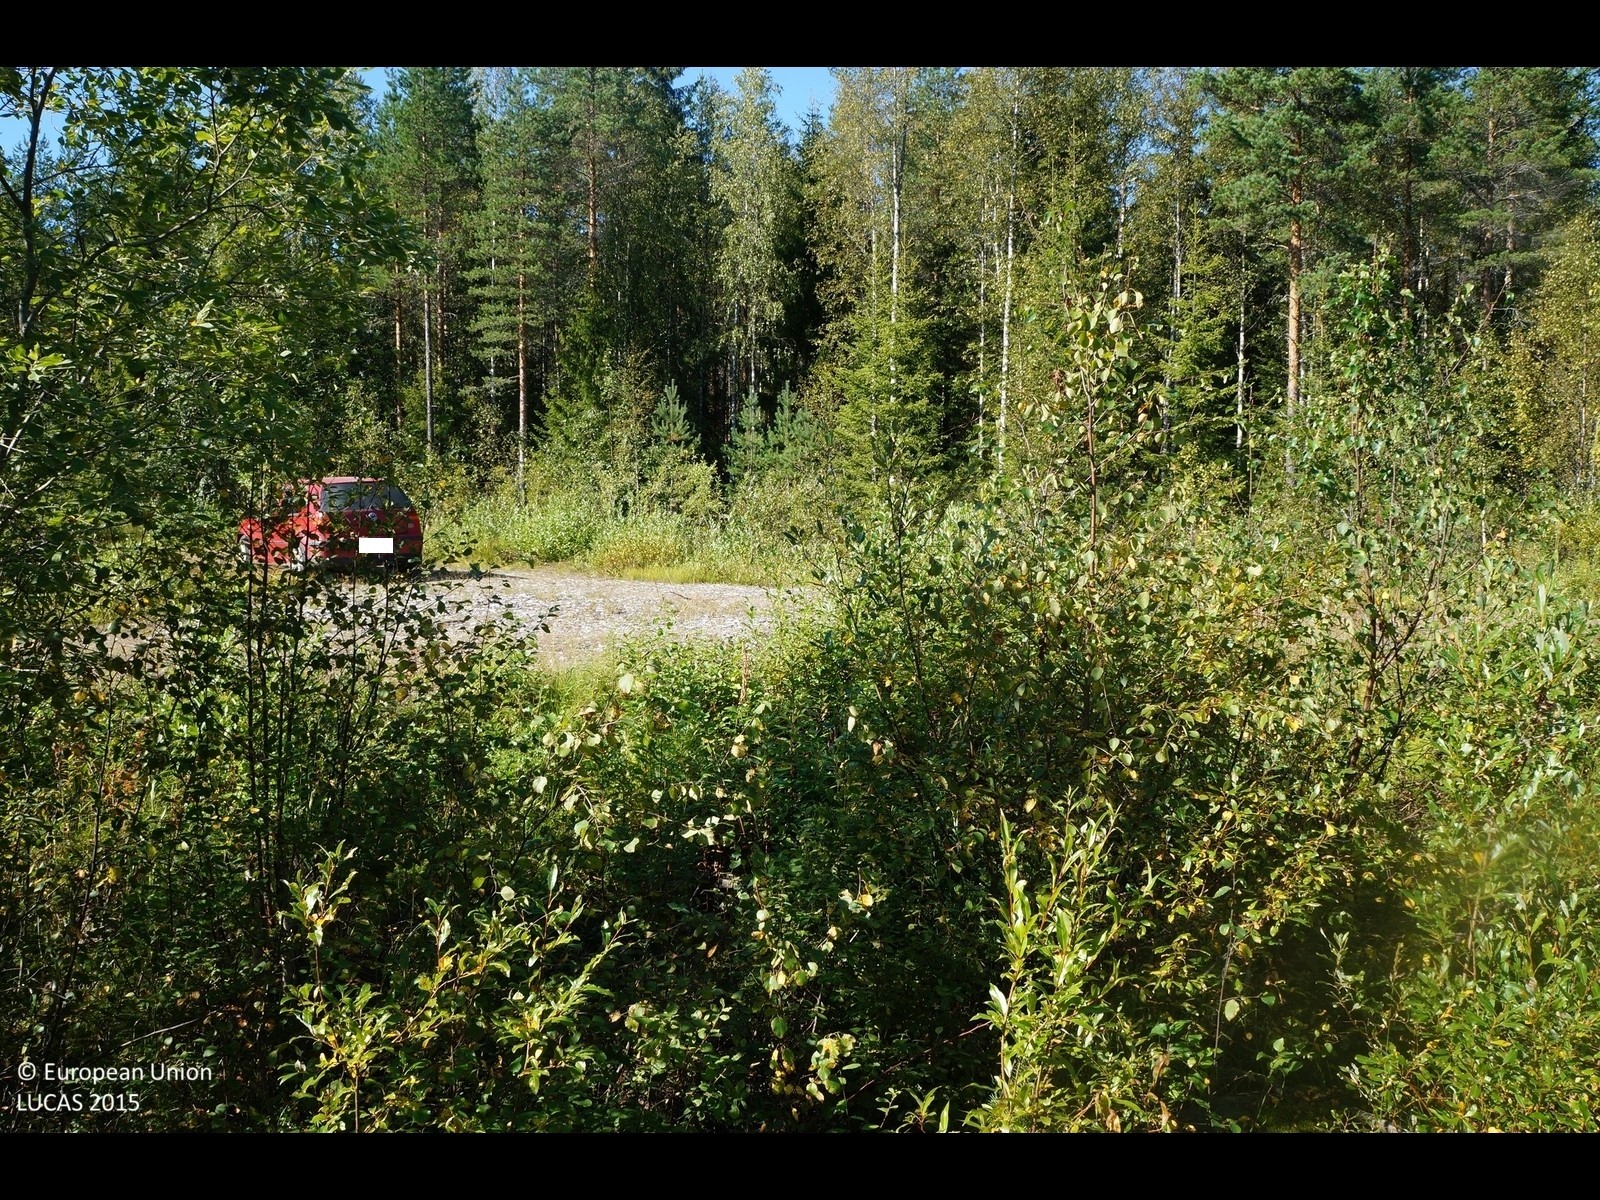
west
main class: Woodland
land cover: Pine dominated mixed woodland
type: boreal forest
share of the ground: 25 - 50 %
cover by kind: shrubs 60 %, coniferous forest trees 30 %, broadleaved forest trees 10 %
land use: Forestry
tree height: < 5 m
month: August
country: FI
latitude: 64.0082
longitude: 25.0357
